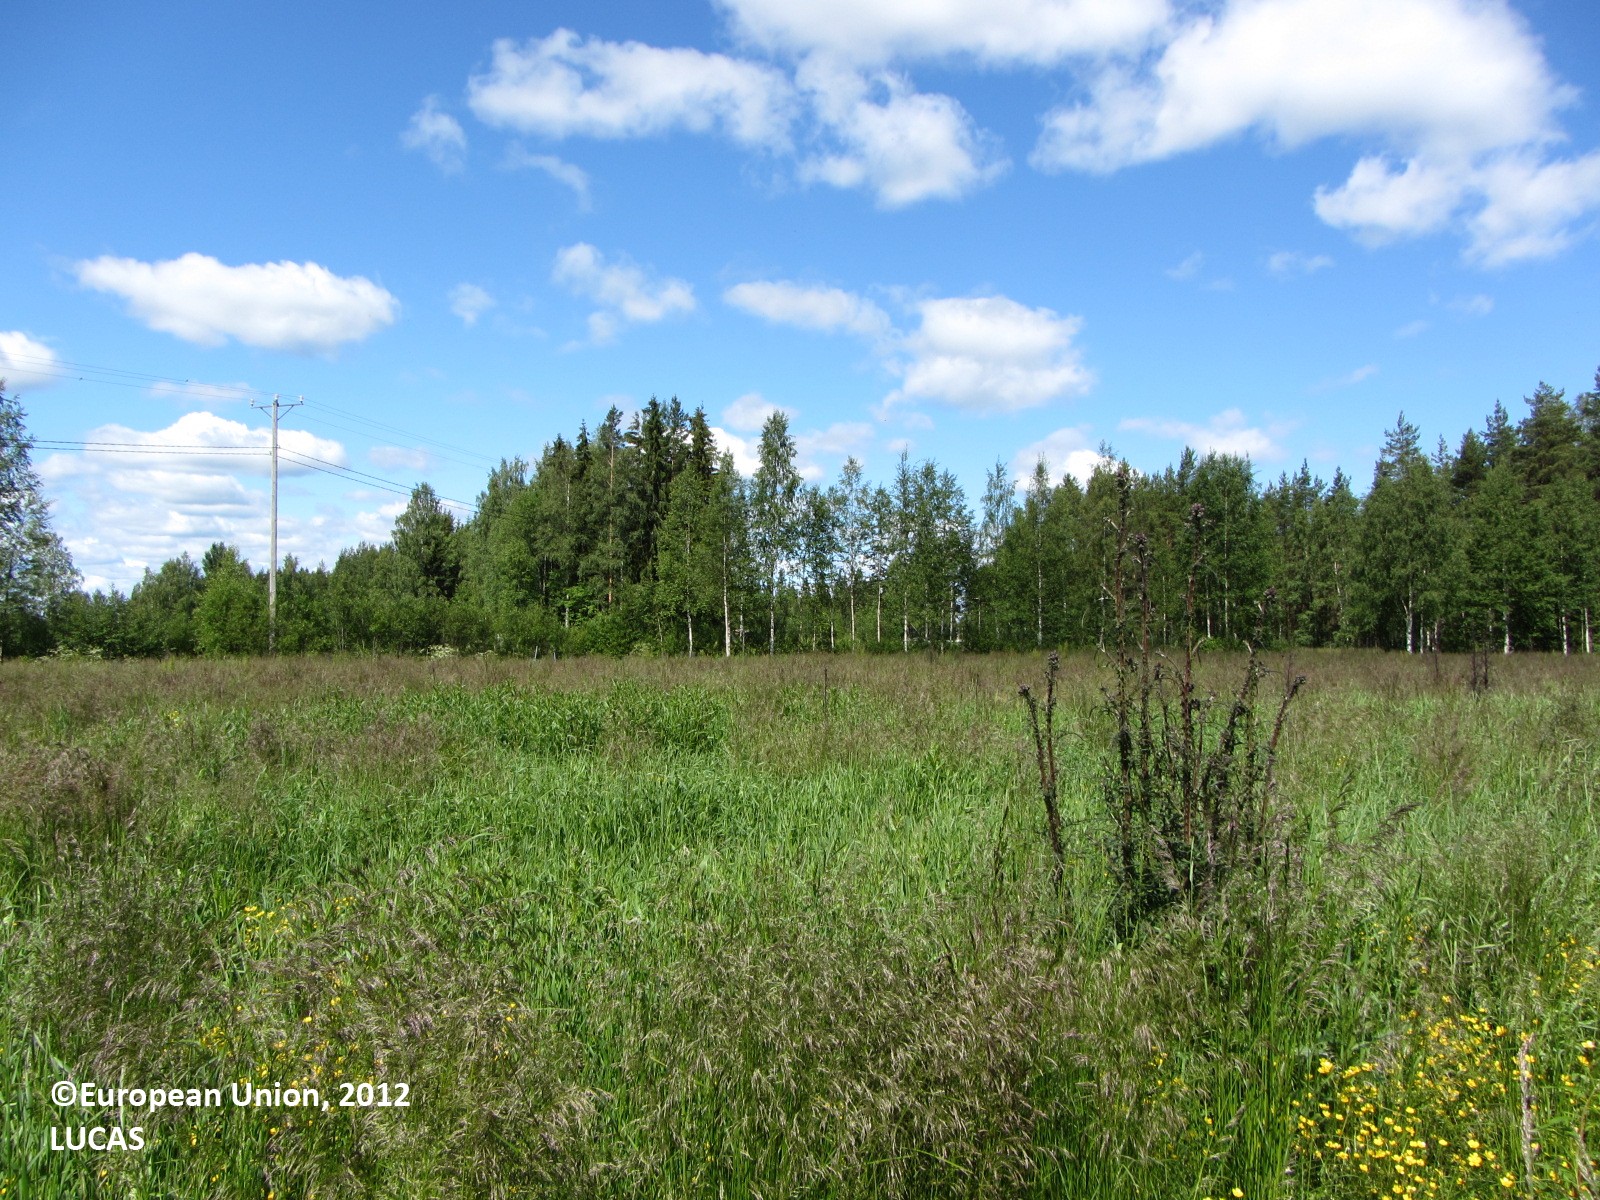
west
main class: Grassland
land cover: Spontaneously vegetated surfaces
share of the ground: > 75 %
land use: Fallow land
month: June
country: FI
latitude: 62.6000
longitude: 25.2788
